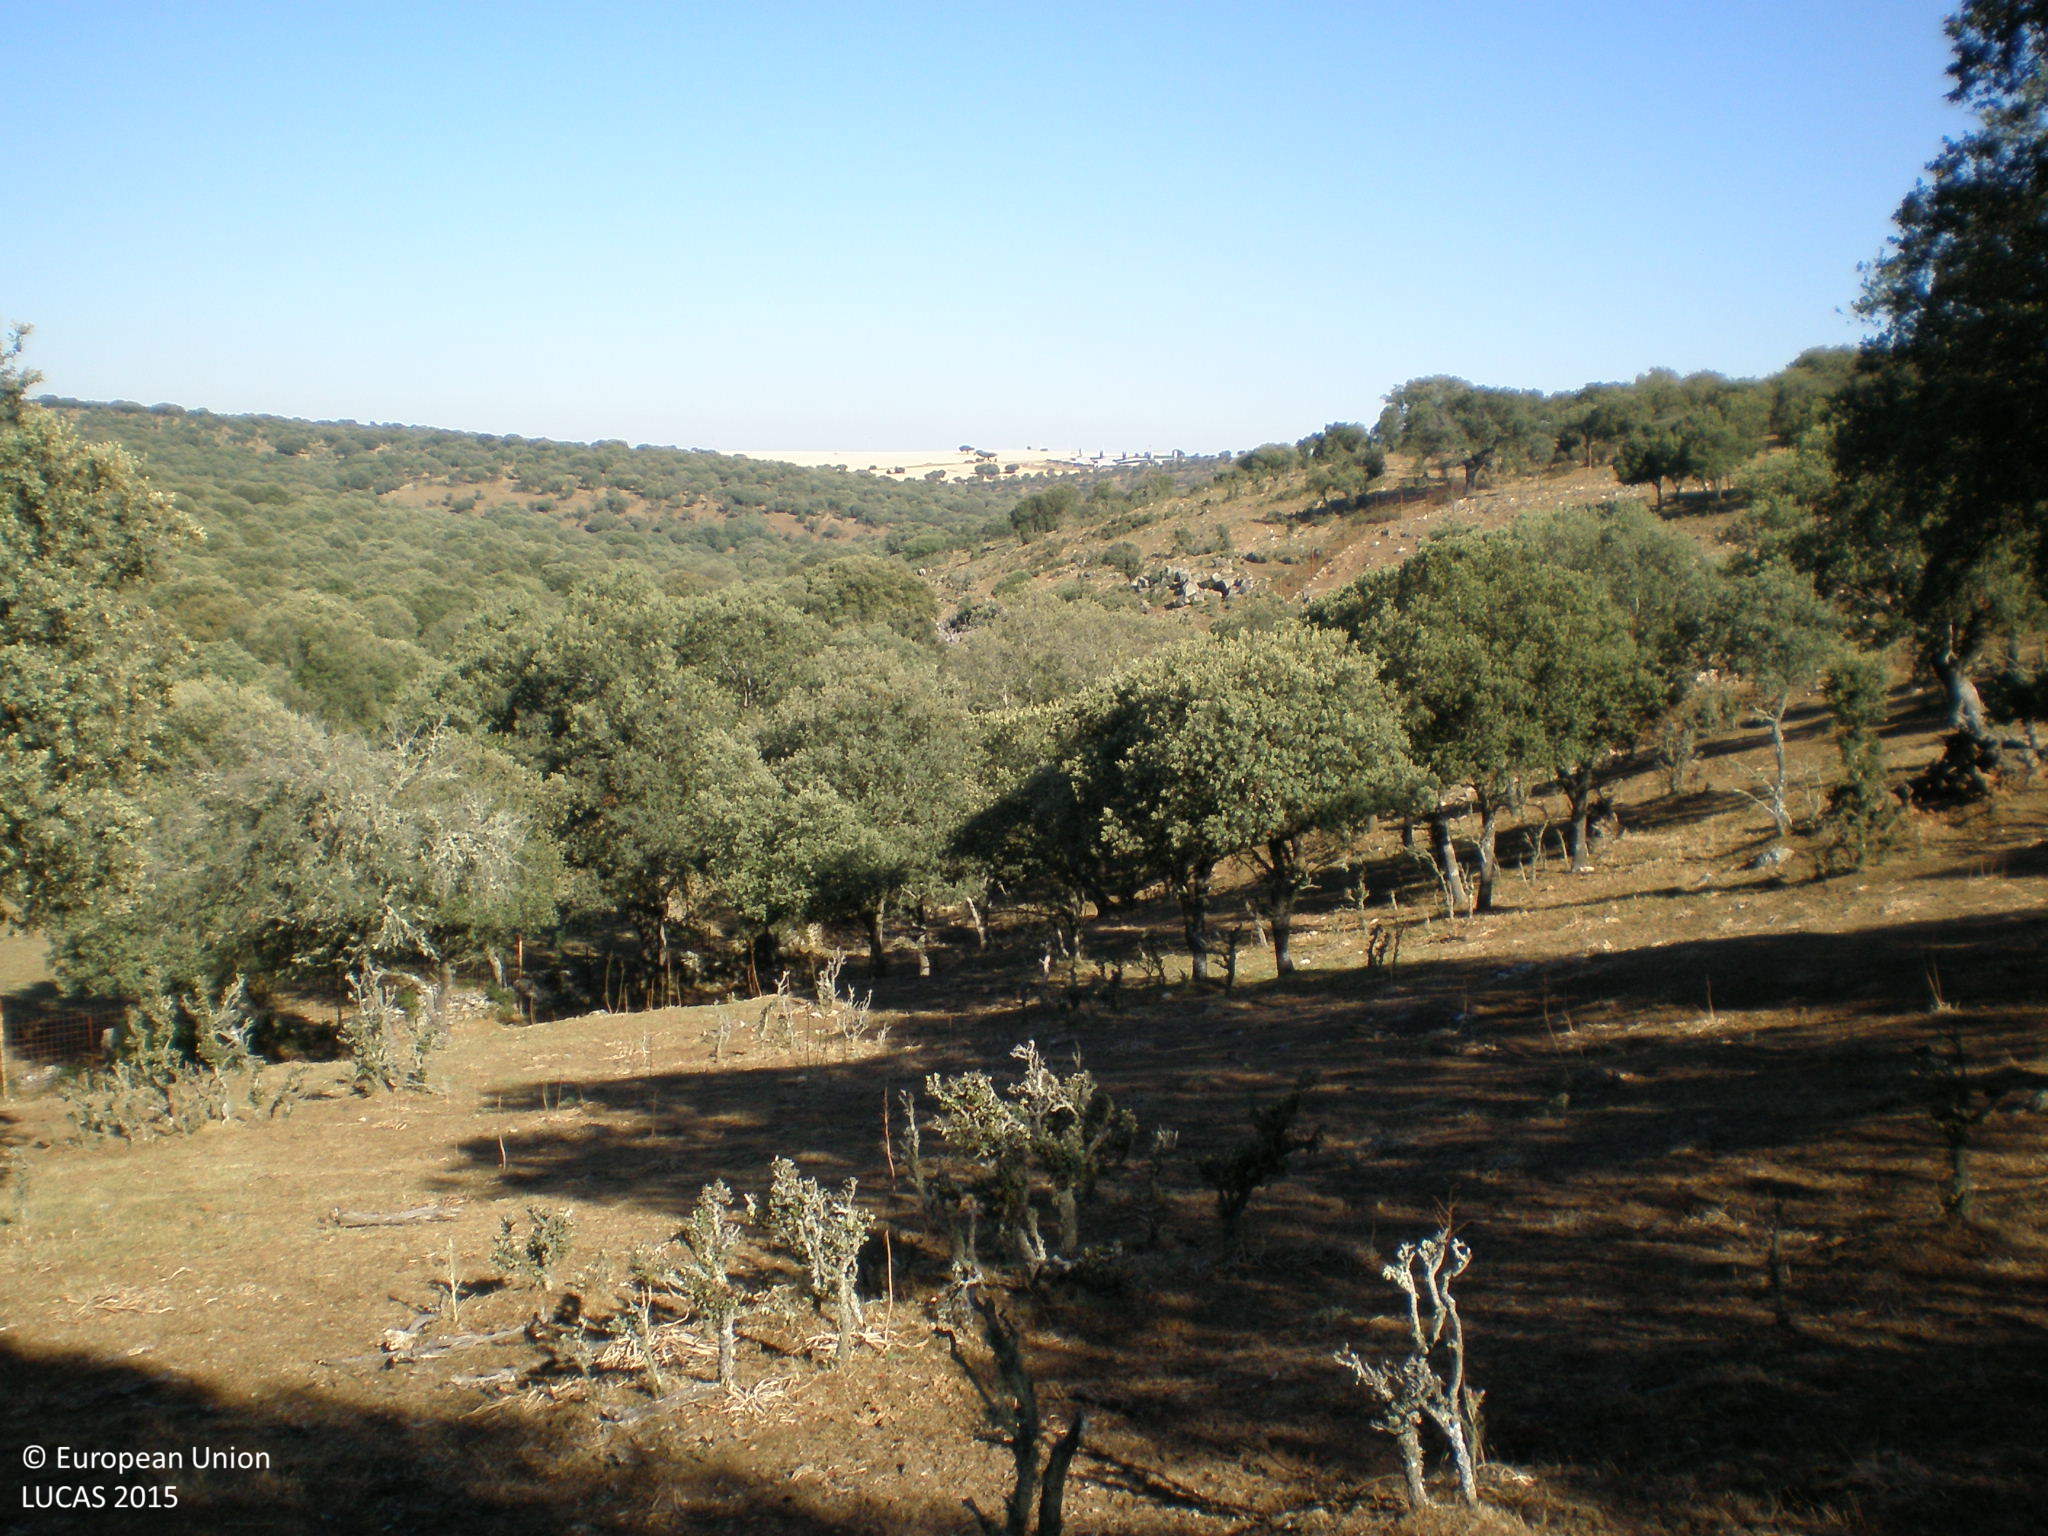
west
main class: Woodland
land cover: Broadleaved woodland
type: broadleaved evergreen forest
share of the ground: 25 - 50 %
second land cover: Grassland without tree/shrub cover
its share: 50 - 75 %
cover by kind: herbaceous plants 55 %, broadleaved forest trees 45 %
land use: Forestry
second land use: Agriculture (excluding fallow land and kitchen gardens)
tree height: > 5 m
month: June
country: ES
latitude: 40.8339
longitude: -5.6939
